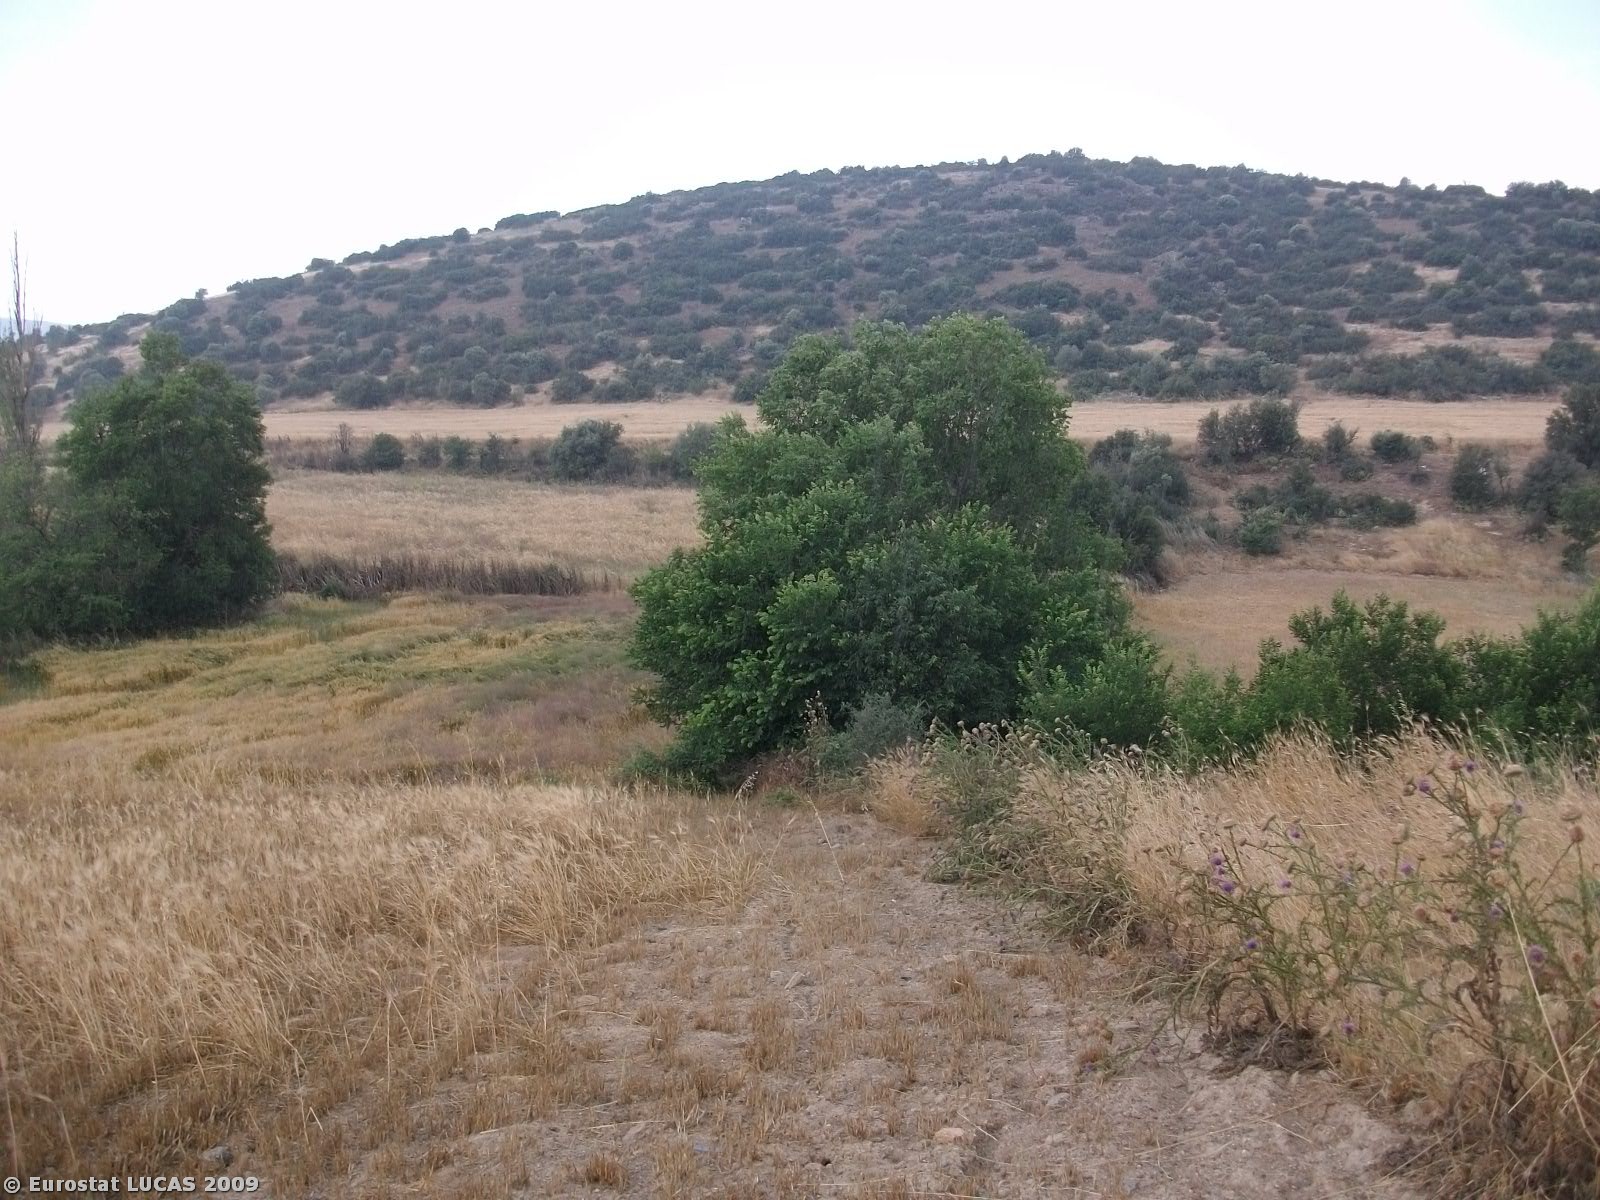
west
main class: Cropland
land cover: Durum wheat
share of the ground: < 10 %
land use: Agriculture (excluding fallow land and kitchen gardens)
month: June
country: GR
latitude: 39.7699
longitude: 22.5423
